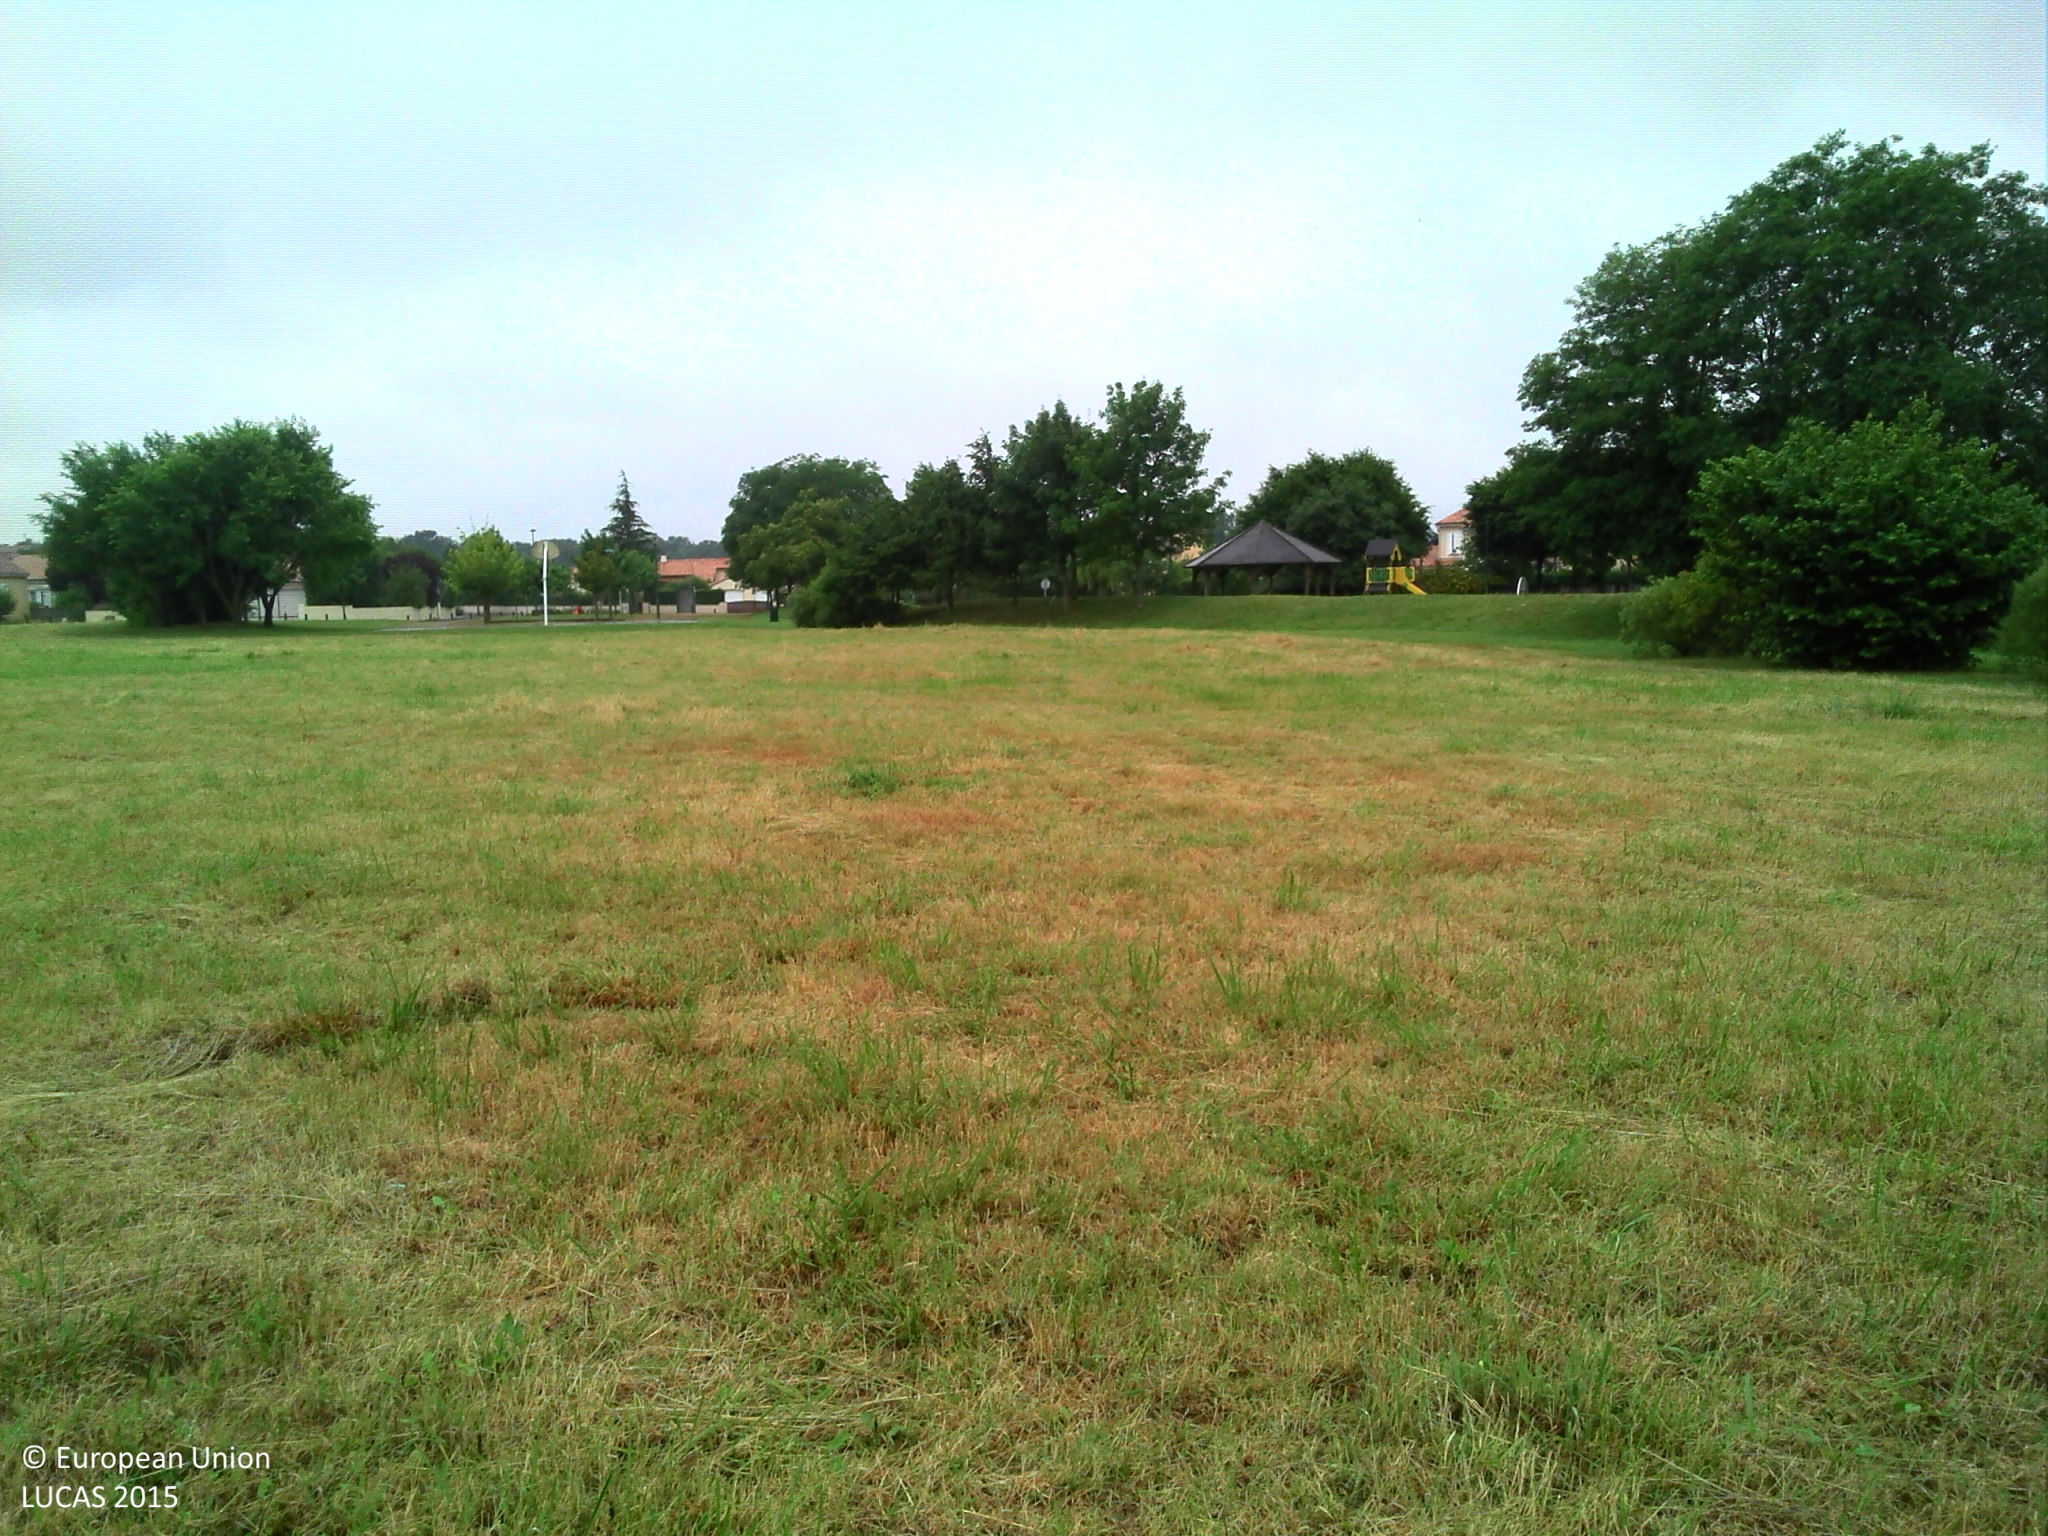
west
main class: Grassland
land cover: Grassland without tree/shrub cover
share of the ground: > 75 %
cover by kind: herbaceous plants 100 %
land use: Agriculture (excluding fallow land and kitchen gardens)
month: June
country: FR
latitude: 46.5433
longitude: 0.2915
